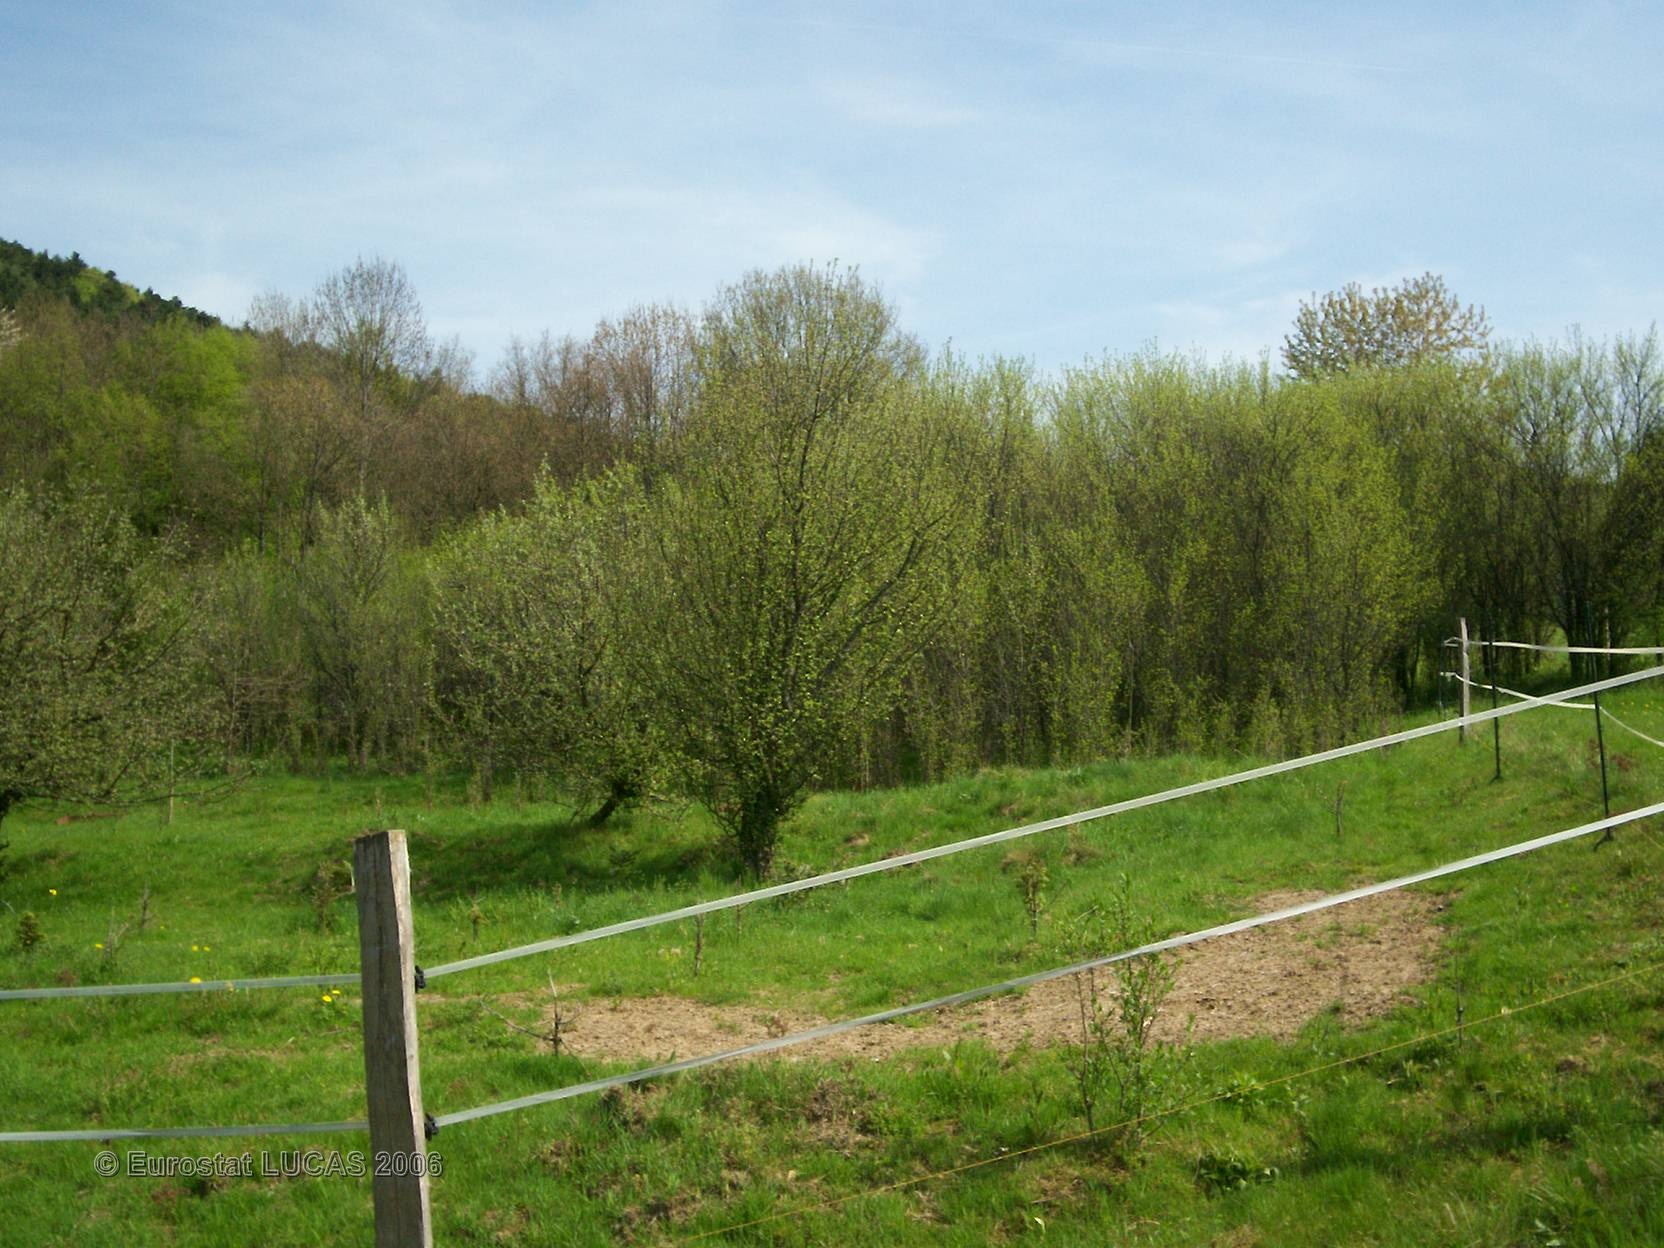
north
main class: Grassland
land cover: Grassland with sparse tree/shrub cover
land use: Agriculture (excluding fallow land and kitchen gardens)
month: May
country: FR
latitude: 47.7858
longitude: 6.9715
